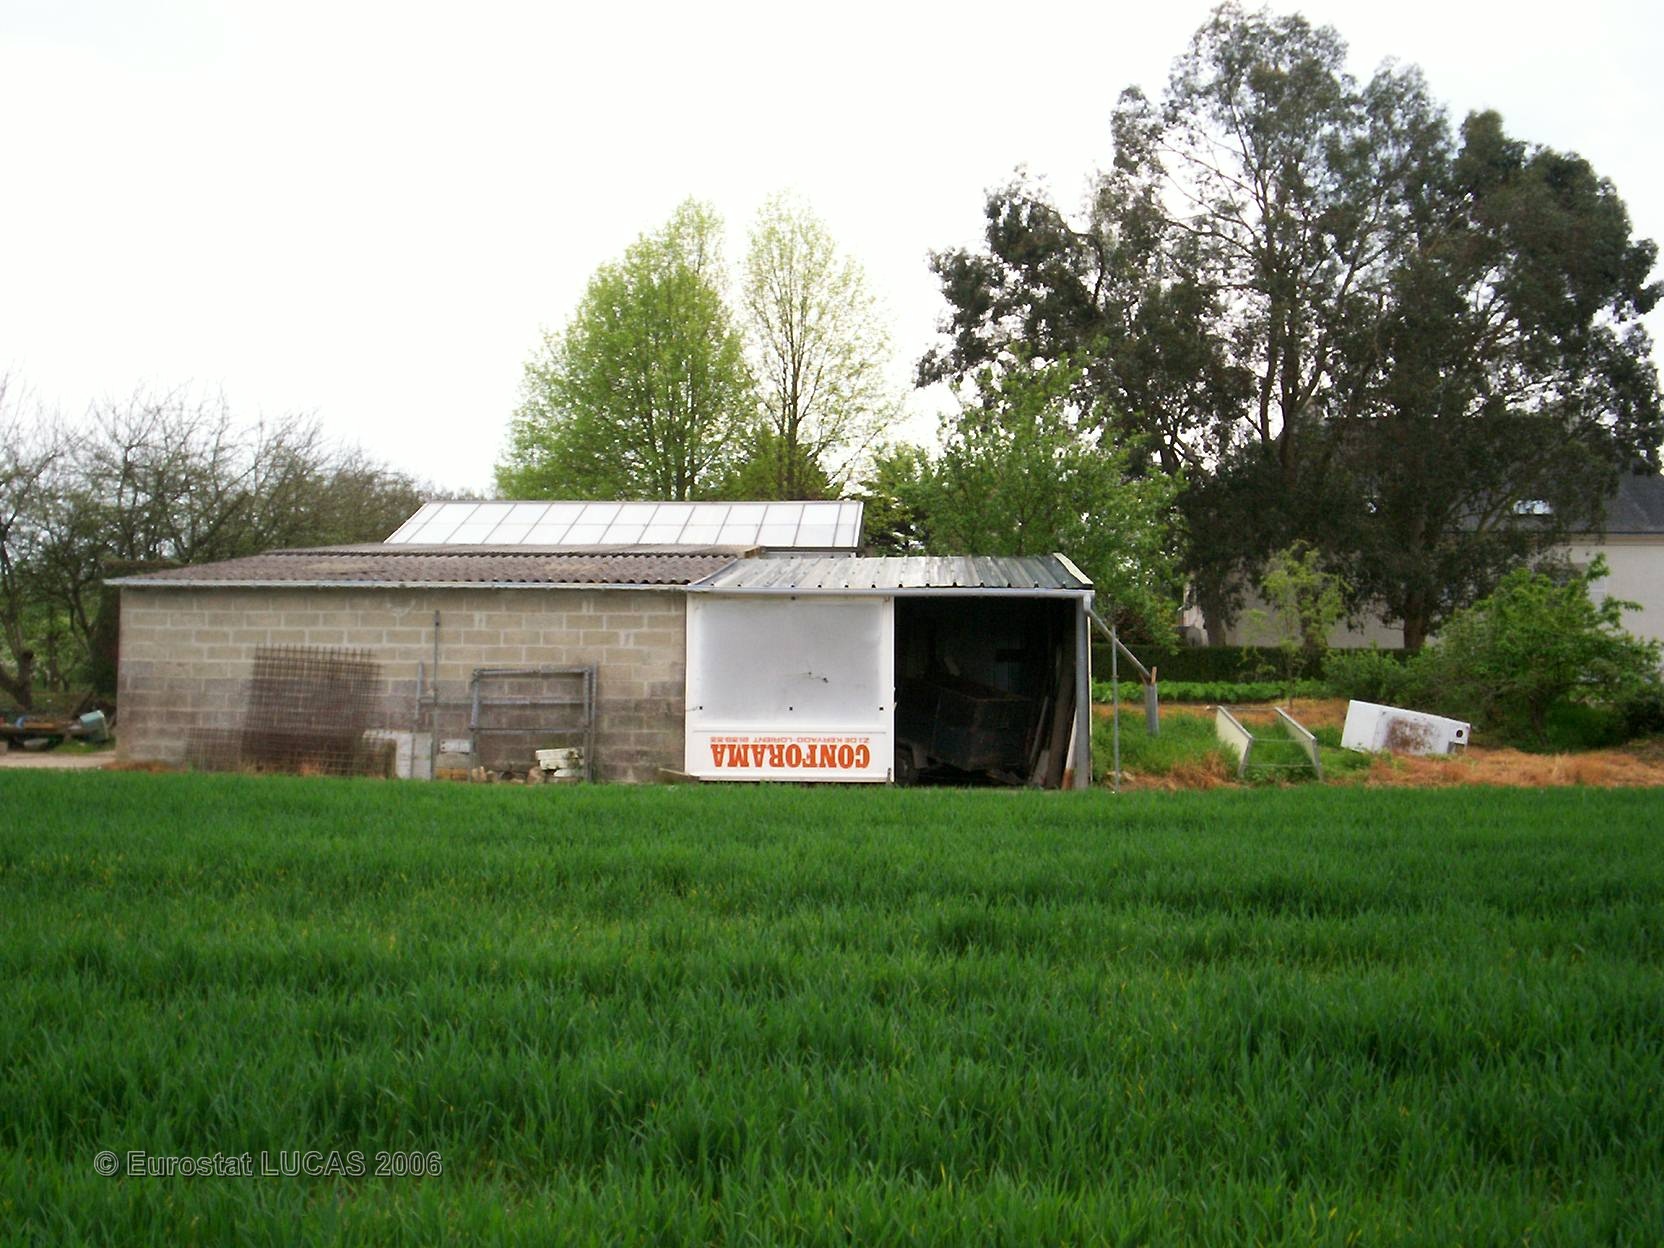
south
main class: Cropland
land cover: Common wheat
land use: Agriculture (excluding fallow land and kitchen gardens)
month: May
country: FR
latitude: 47.8477
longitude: -2.7174
